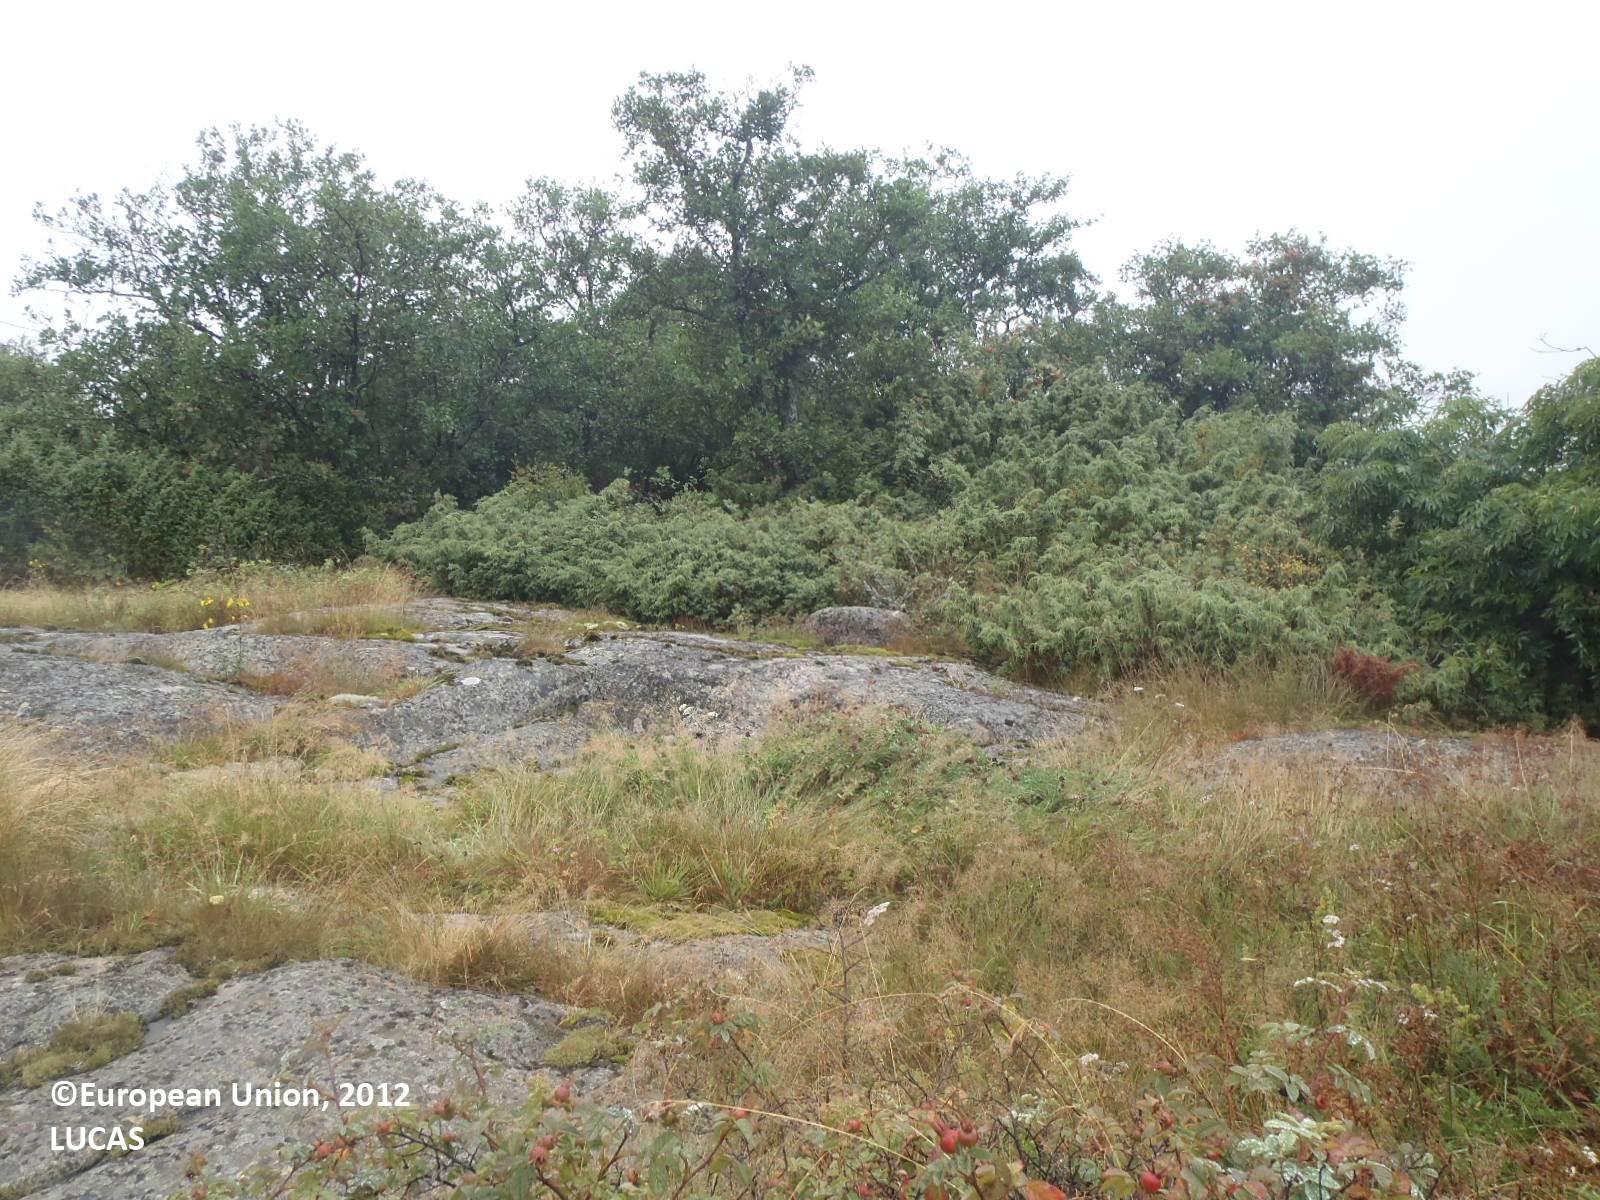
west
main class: Grassland
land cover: Grassland with sparse tree/shrub cover
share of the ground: > 75 %
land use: Semi-natural and natural areas not in use
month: August
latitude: 60.4252
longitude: 20.9674
